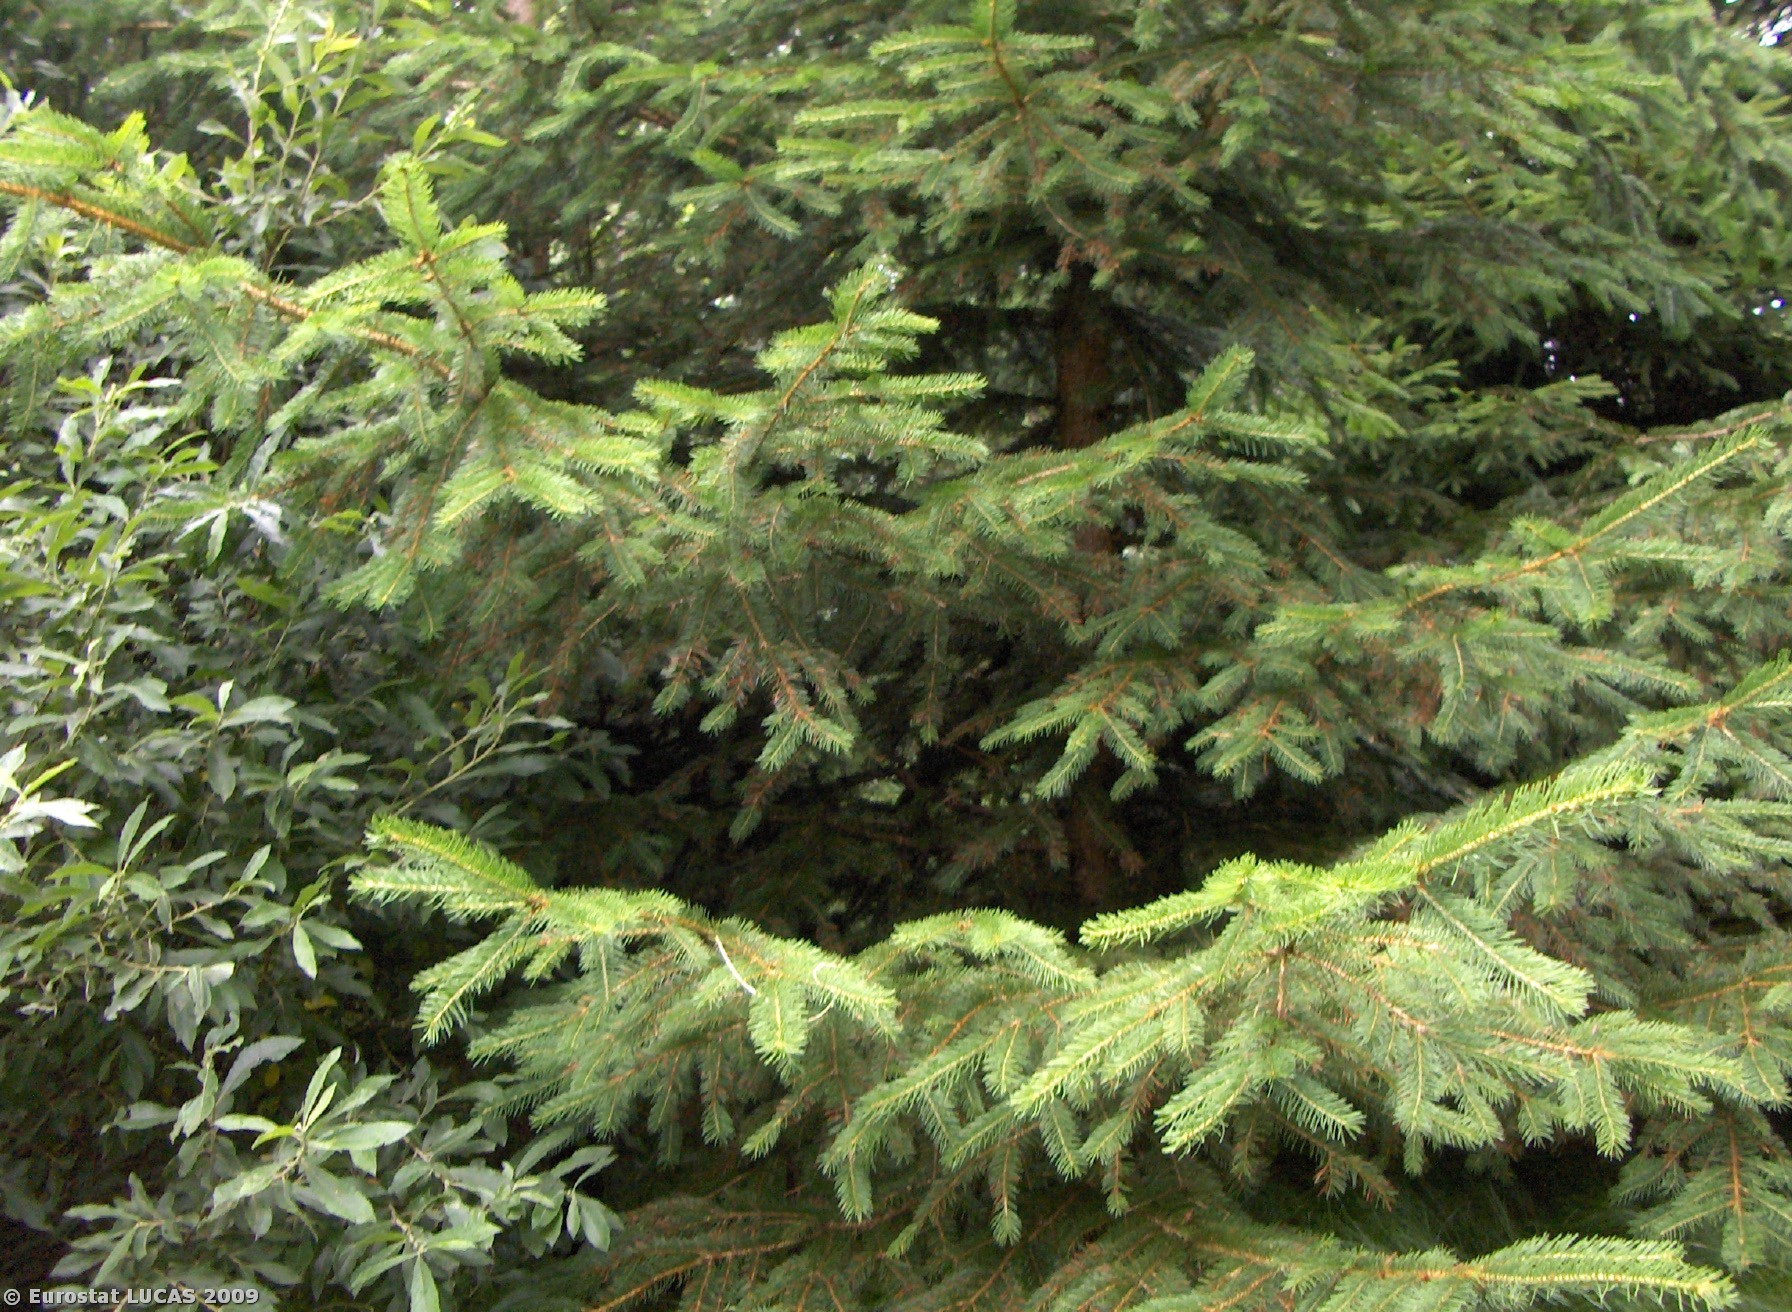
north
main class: Woodland
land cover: Mixed woodland
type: hemiboreal forest and nemoral coniferous forest and mixed broadleaved-coniferous forest
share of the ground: > 75 %
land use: Forestry
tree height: > 5 m
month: July
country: CZ
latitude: 49.4199
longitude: 13.1843
